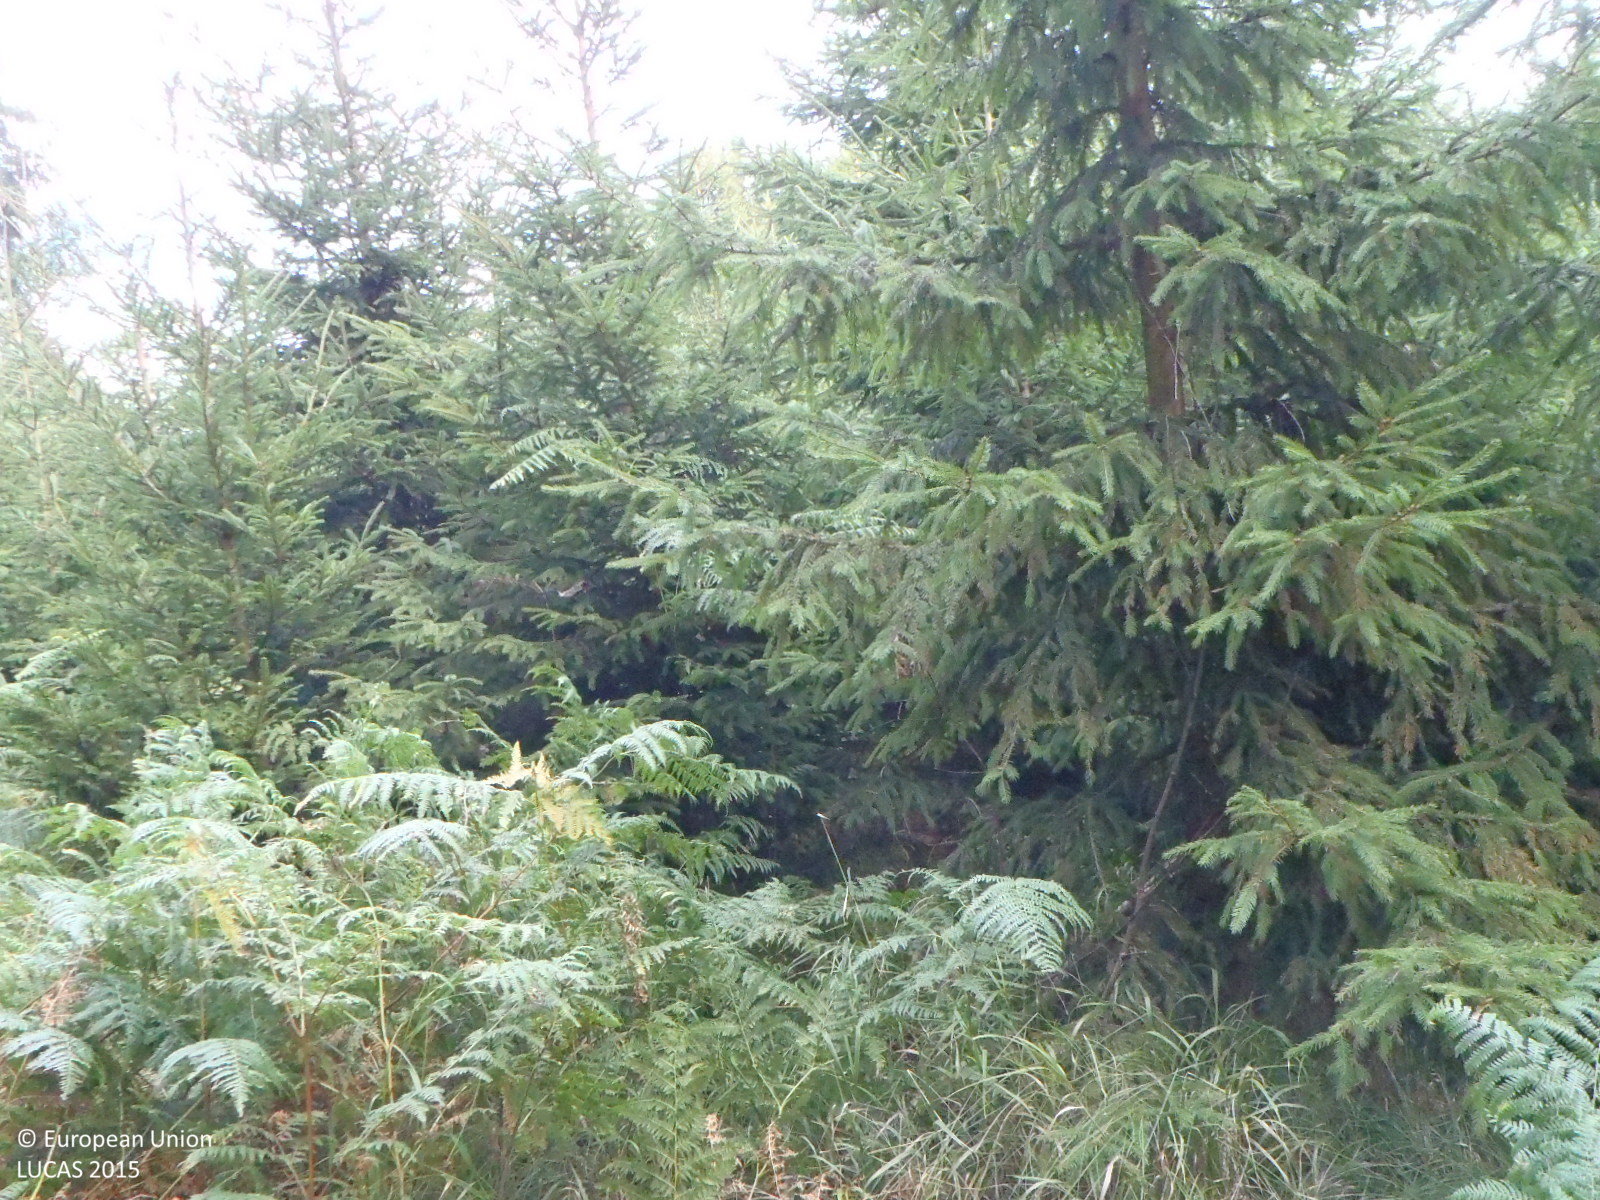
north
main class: Woodland
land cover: Spruce dominated coniferous woodland
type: hemiboreal forest and nemoral coniferous forest and mixed broadleaved-coniferous forest
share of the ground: > 75 %
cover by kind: coniferous forest trees 90 %, herbaceous plants 10 %
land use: Forestry
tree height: > 5 m
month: September
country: CZ
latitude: 50.8106
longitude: 14.1595
